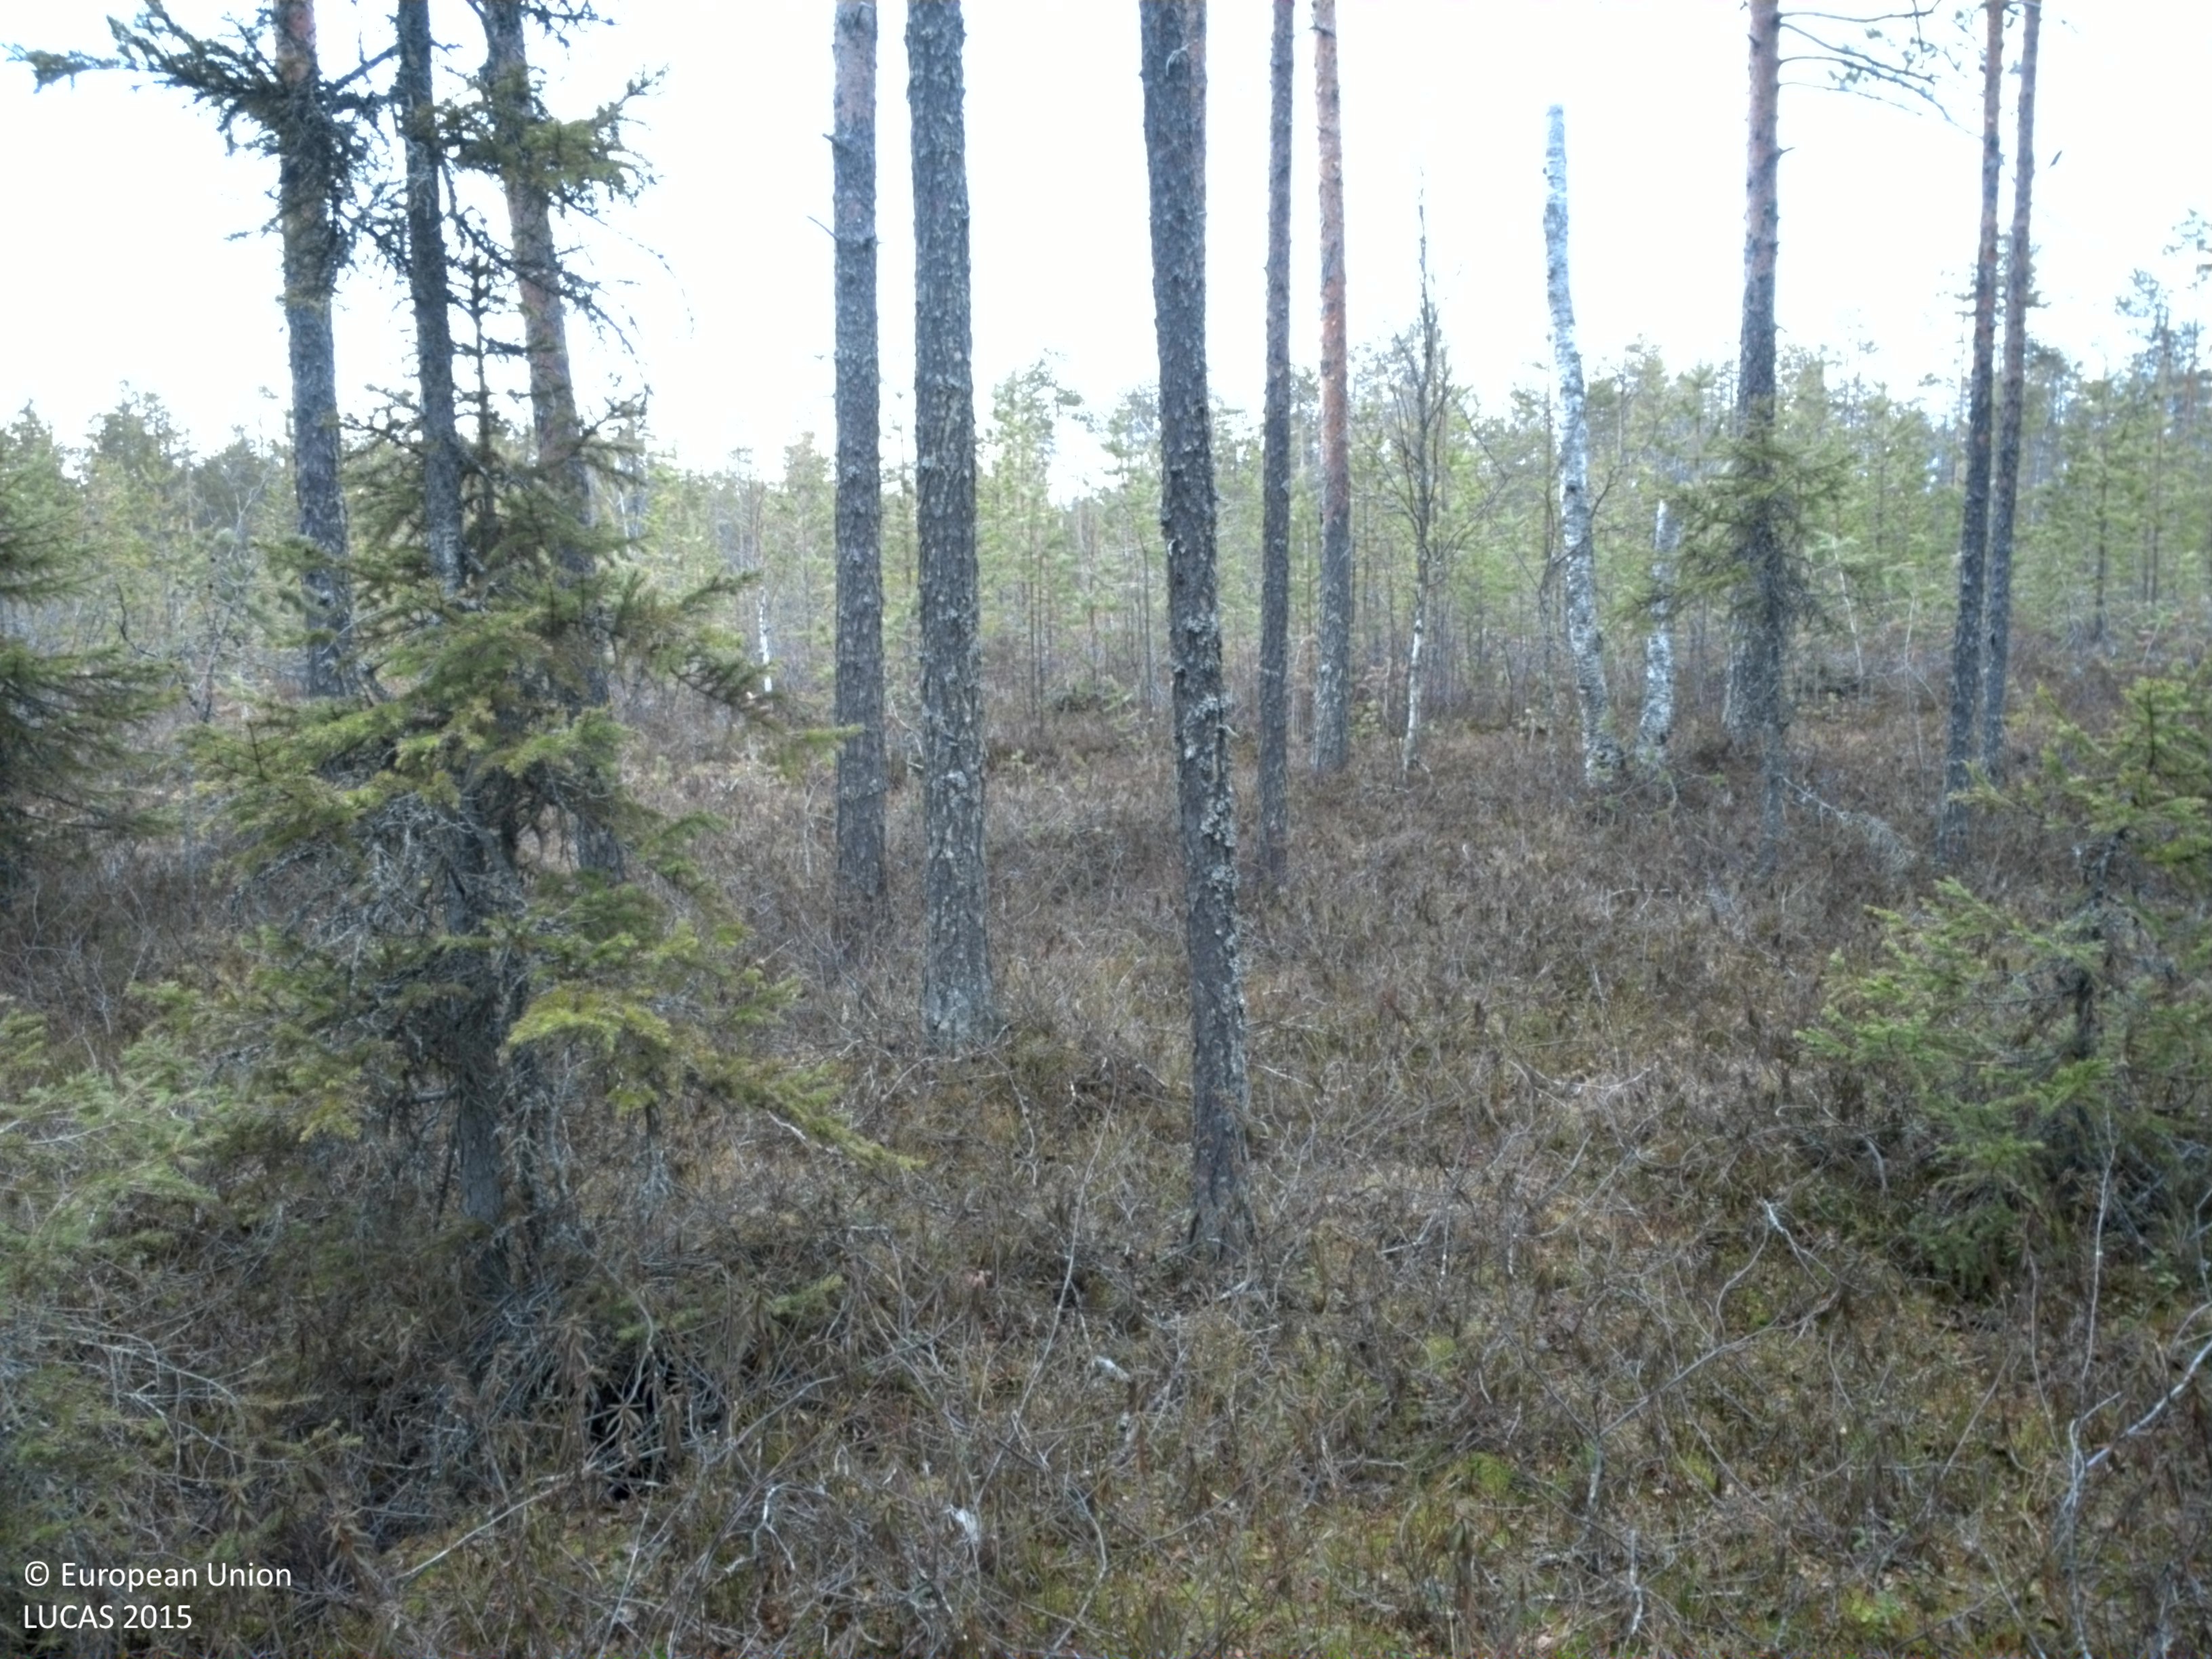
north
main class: Woodland
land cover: Pine dominated coniferous woodland
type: boreal forest
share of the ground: 50 - 75 %
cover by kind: coniferous forest trees 60 %, shrubs 40 %
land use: Forestry
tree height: > 5 m
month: May
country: SE
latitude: 65.8536
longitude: 22.8884
